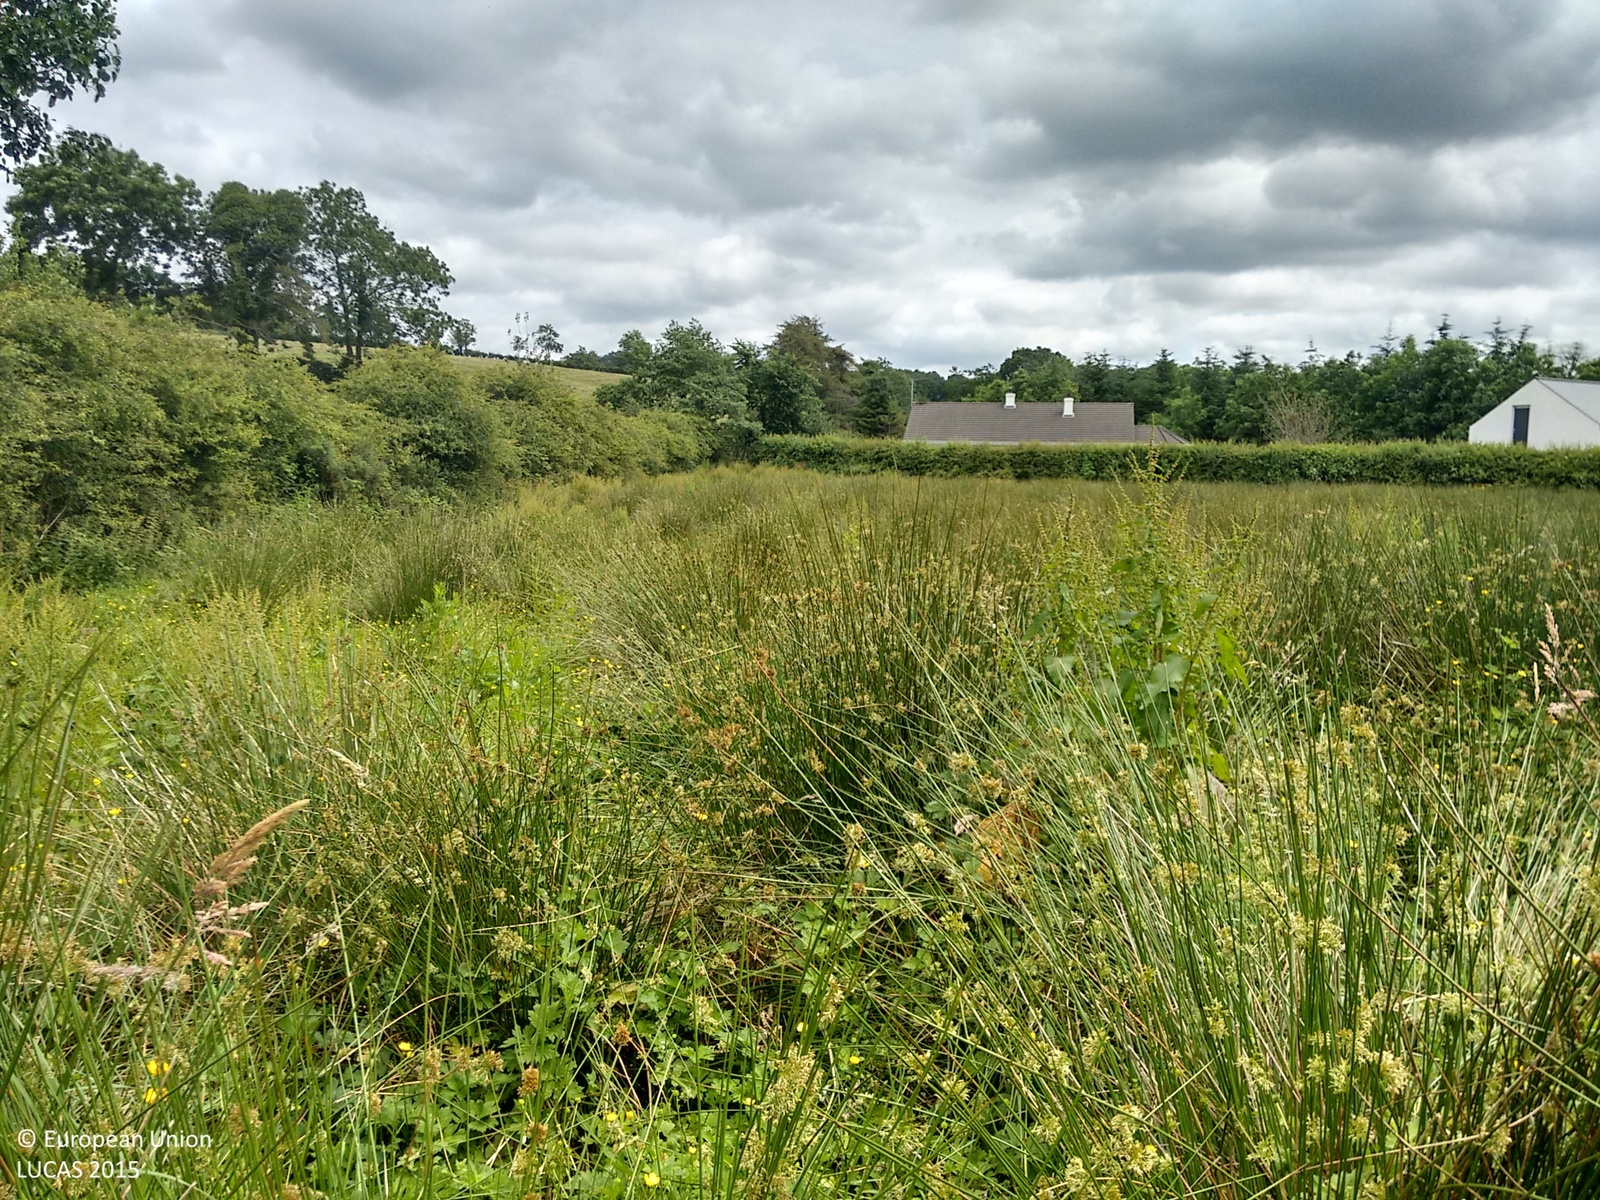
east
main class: Grassland
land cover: Grassland without tree/shrub cover
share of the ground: > 75 %
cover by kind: herbaceous plants 100 %
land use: Agriculture (excluding fallow land and kitchen gardens)
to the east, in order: Grassland without tree/shrub cover; Abandoned hedges; Fences; Abandoned hedges; Grassland without tree/shrub cover; Fences; Grass margins; Paved roads, cycling and walking lanes; Grass margins; Abandoned hedges; Grassland without tree/shrub cover; Ditches and canals; Fences; Abandoned hedges; Grassland without tree/shrub cover
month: July
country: GB
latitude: 54.6303
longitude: -7.2969
